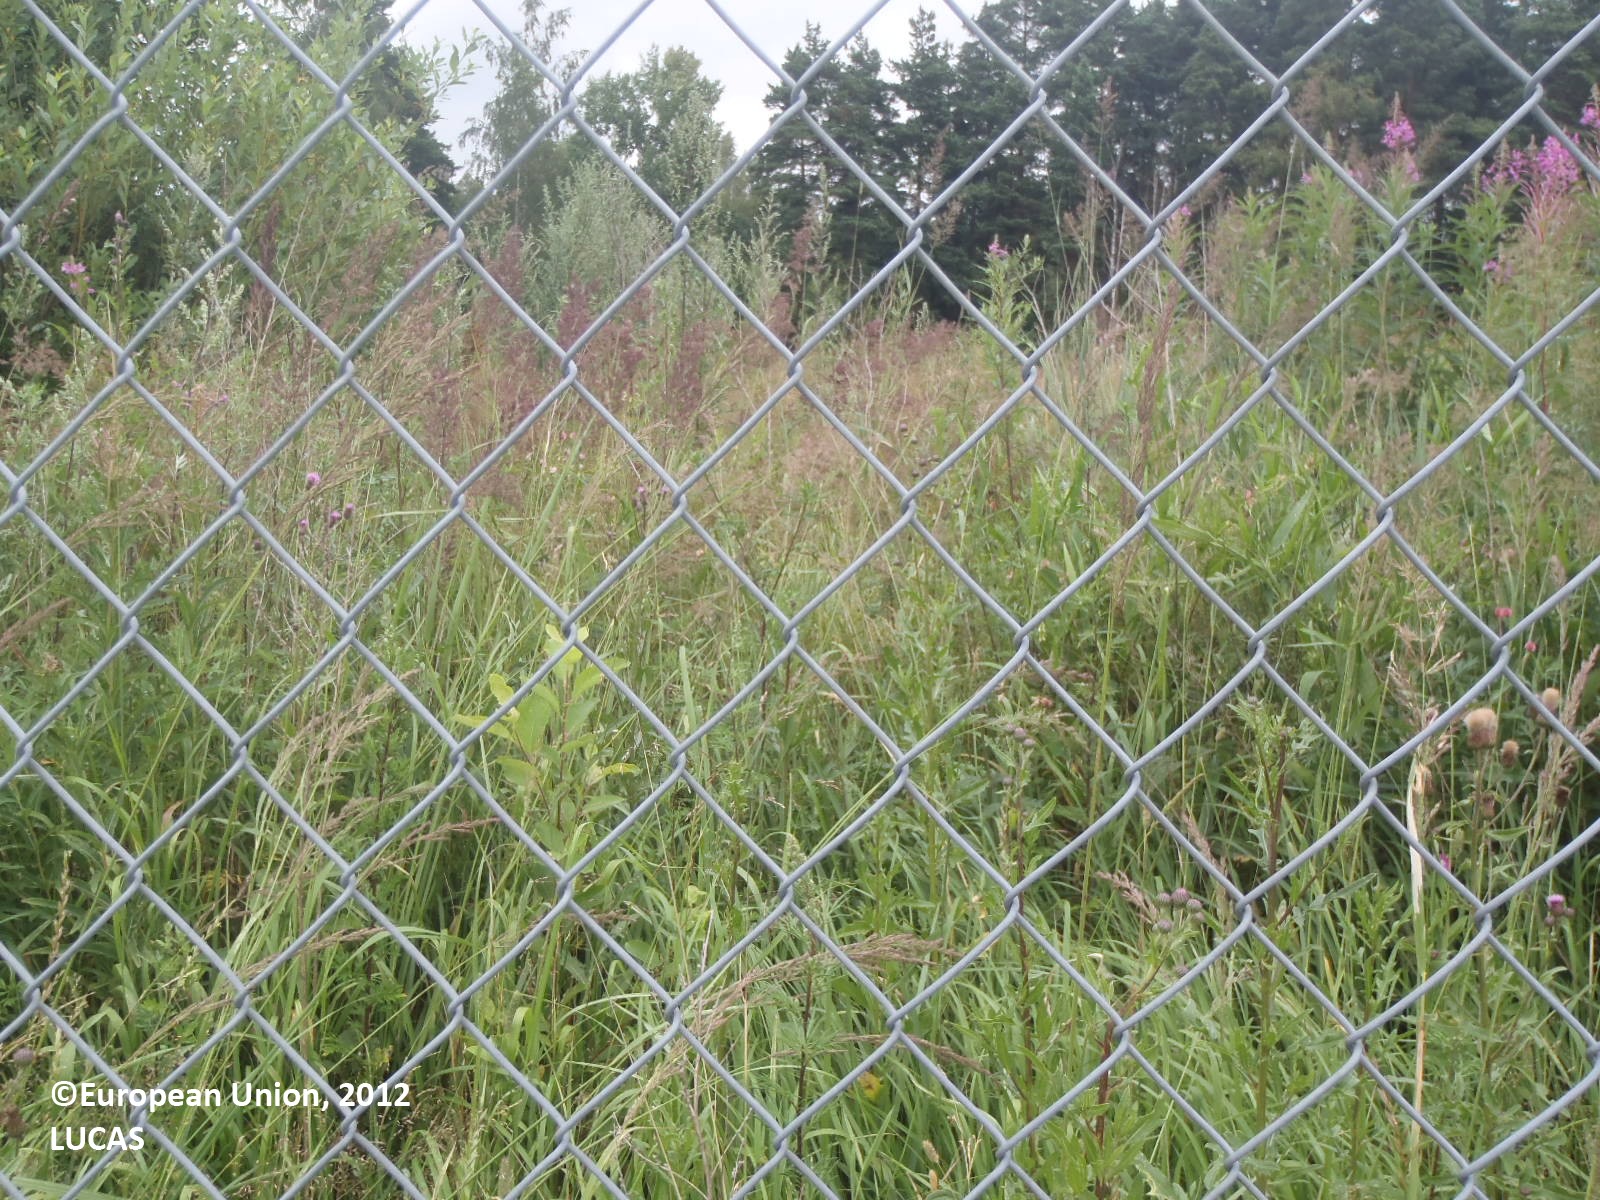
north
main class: Grassland
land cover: Grassland with sparse tree/shrub cover
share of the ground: > 75 %
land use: Abandoned areas
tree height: < 5 m
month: July
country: FI
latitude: 60.5024
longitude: 22.2469
